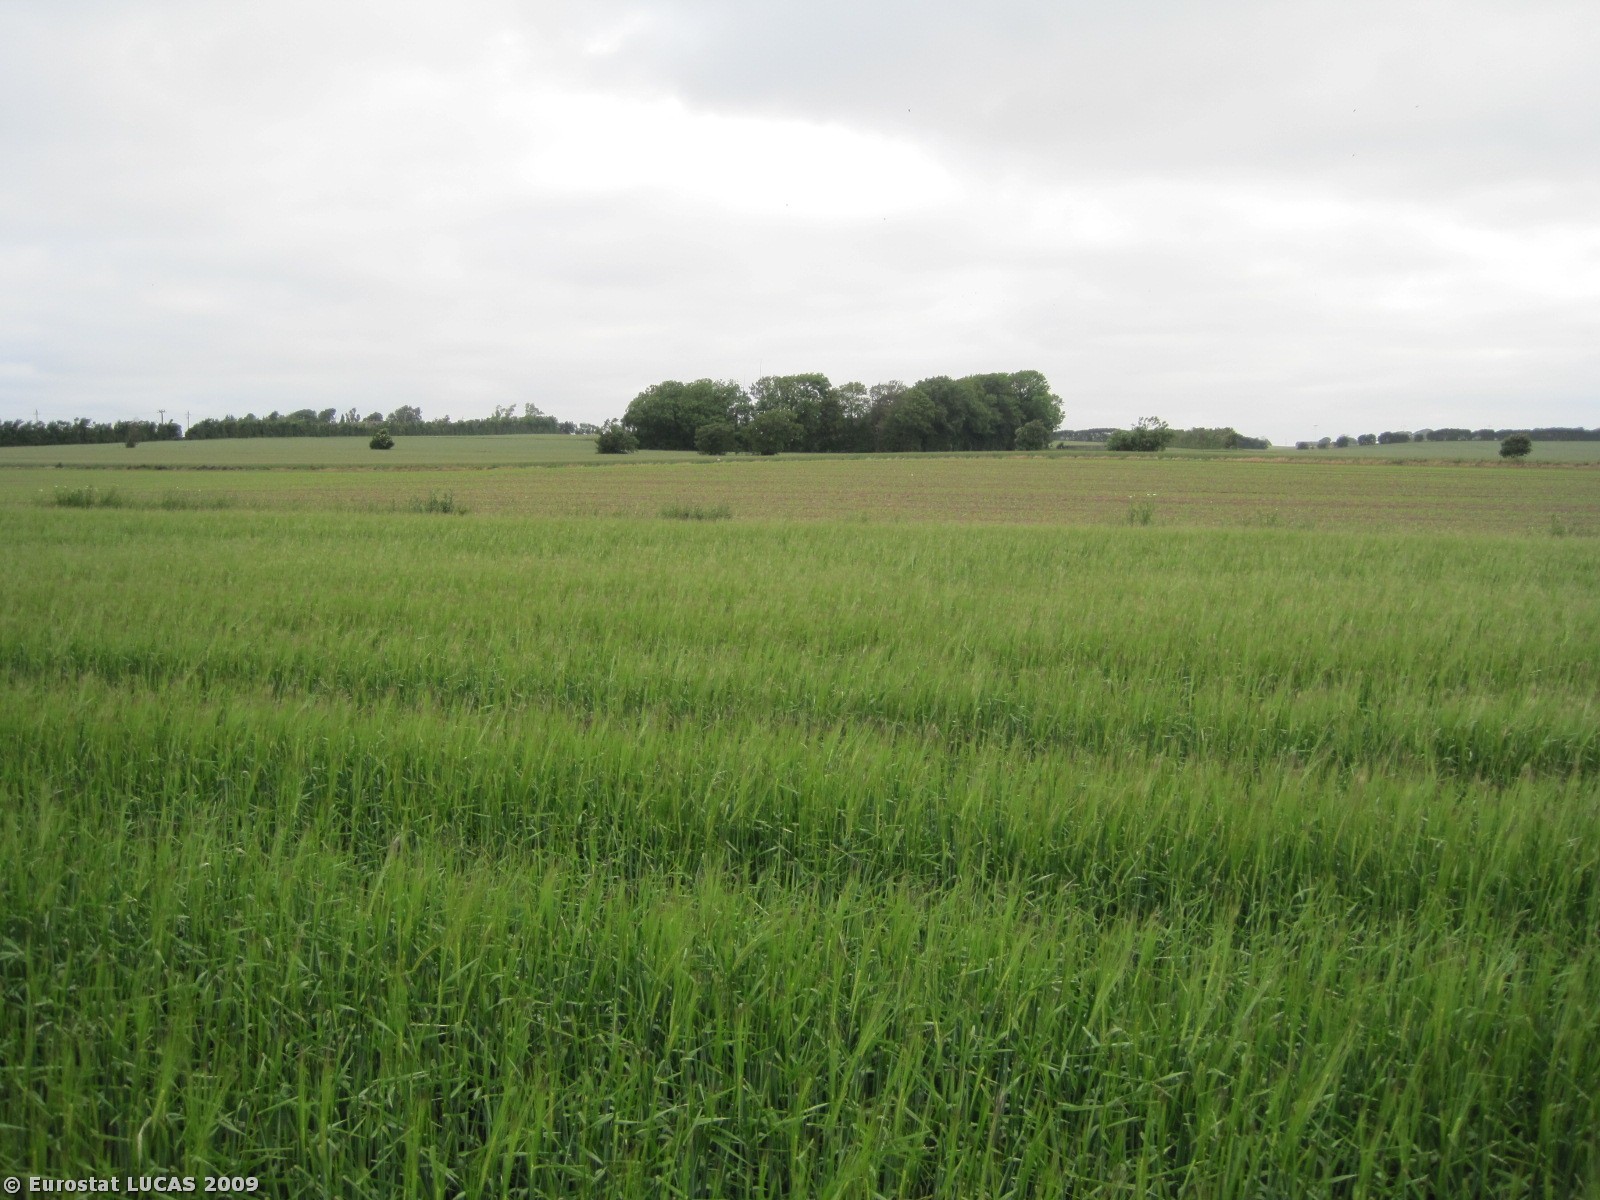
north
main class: Cropland
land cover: Barley
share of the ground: > 75 %
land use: Agriculture (excluding fallow land and kitchen gardens)
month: June
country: DK
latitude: 56.7206
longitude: 8.7108
